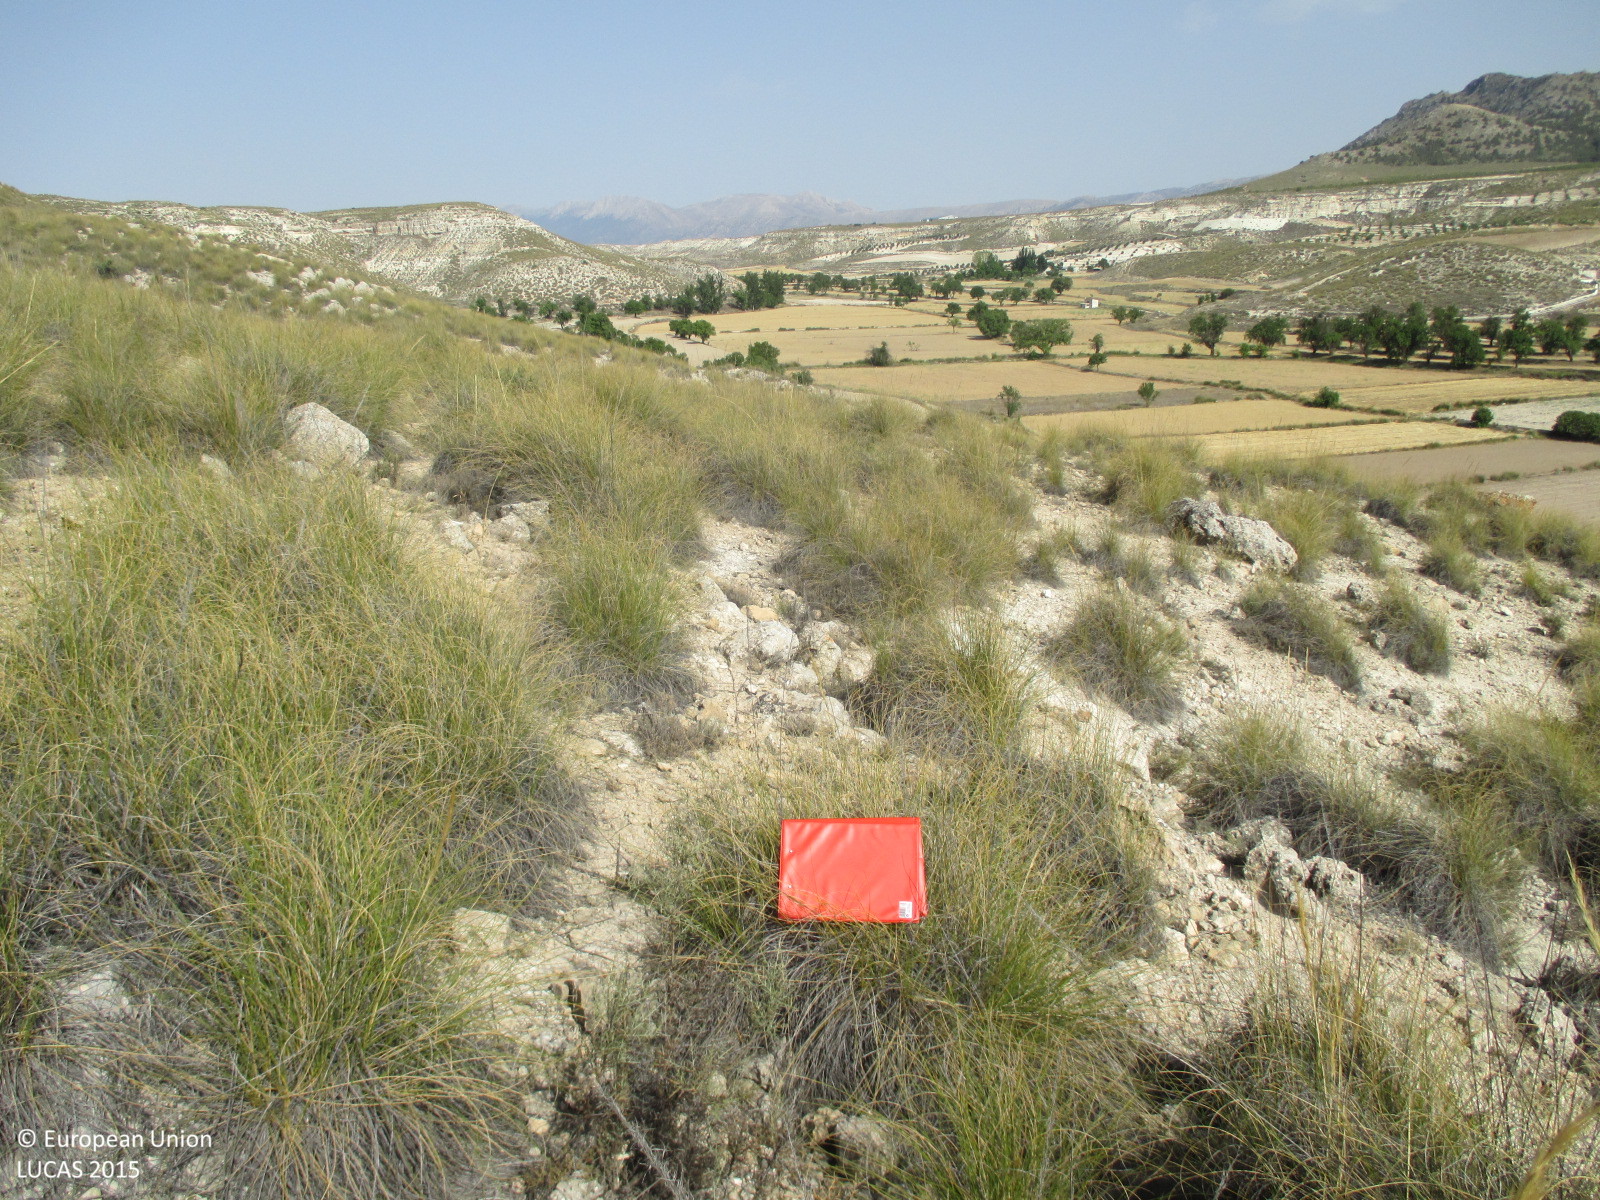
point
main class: Grassland
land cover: Grassland without tree/shrub cover
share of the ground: 50 - 75 %
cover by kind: herbaceous plants 55 %, unconsolidated bare surface 40 %, consolidated bare surface 5 %
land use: Semi-natural and natural areas not in use
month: June
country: ES
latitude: 37.7311
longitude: -2.4581
